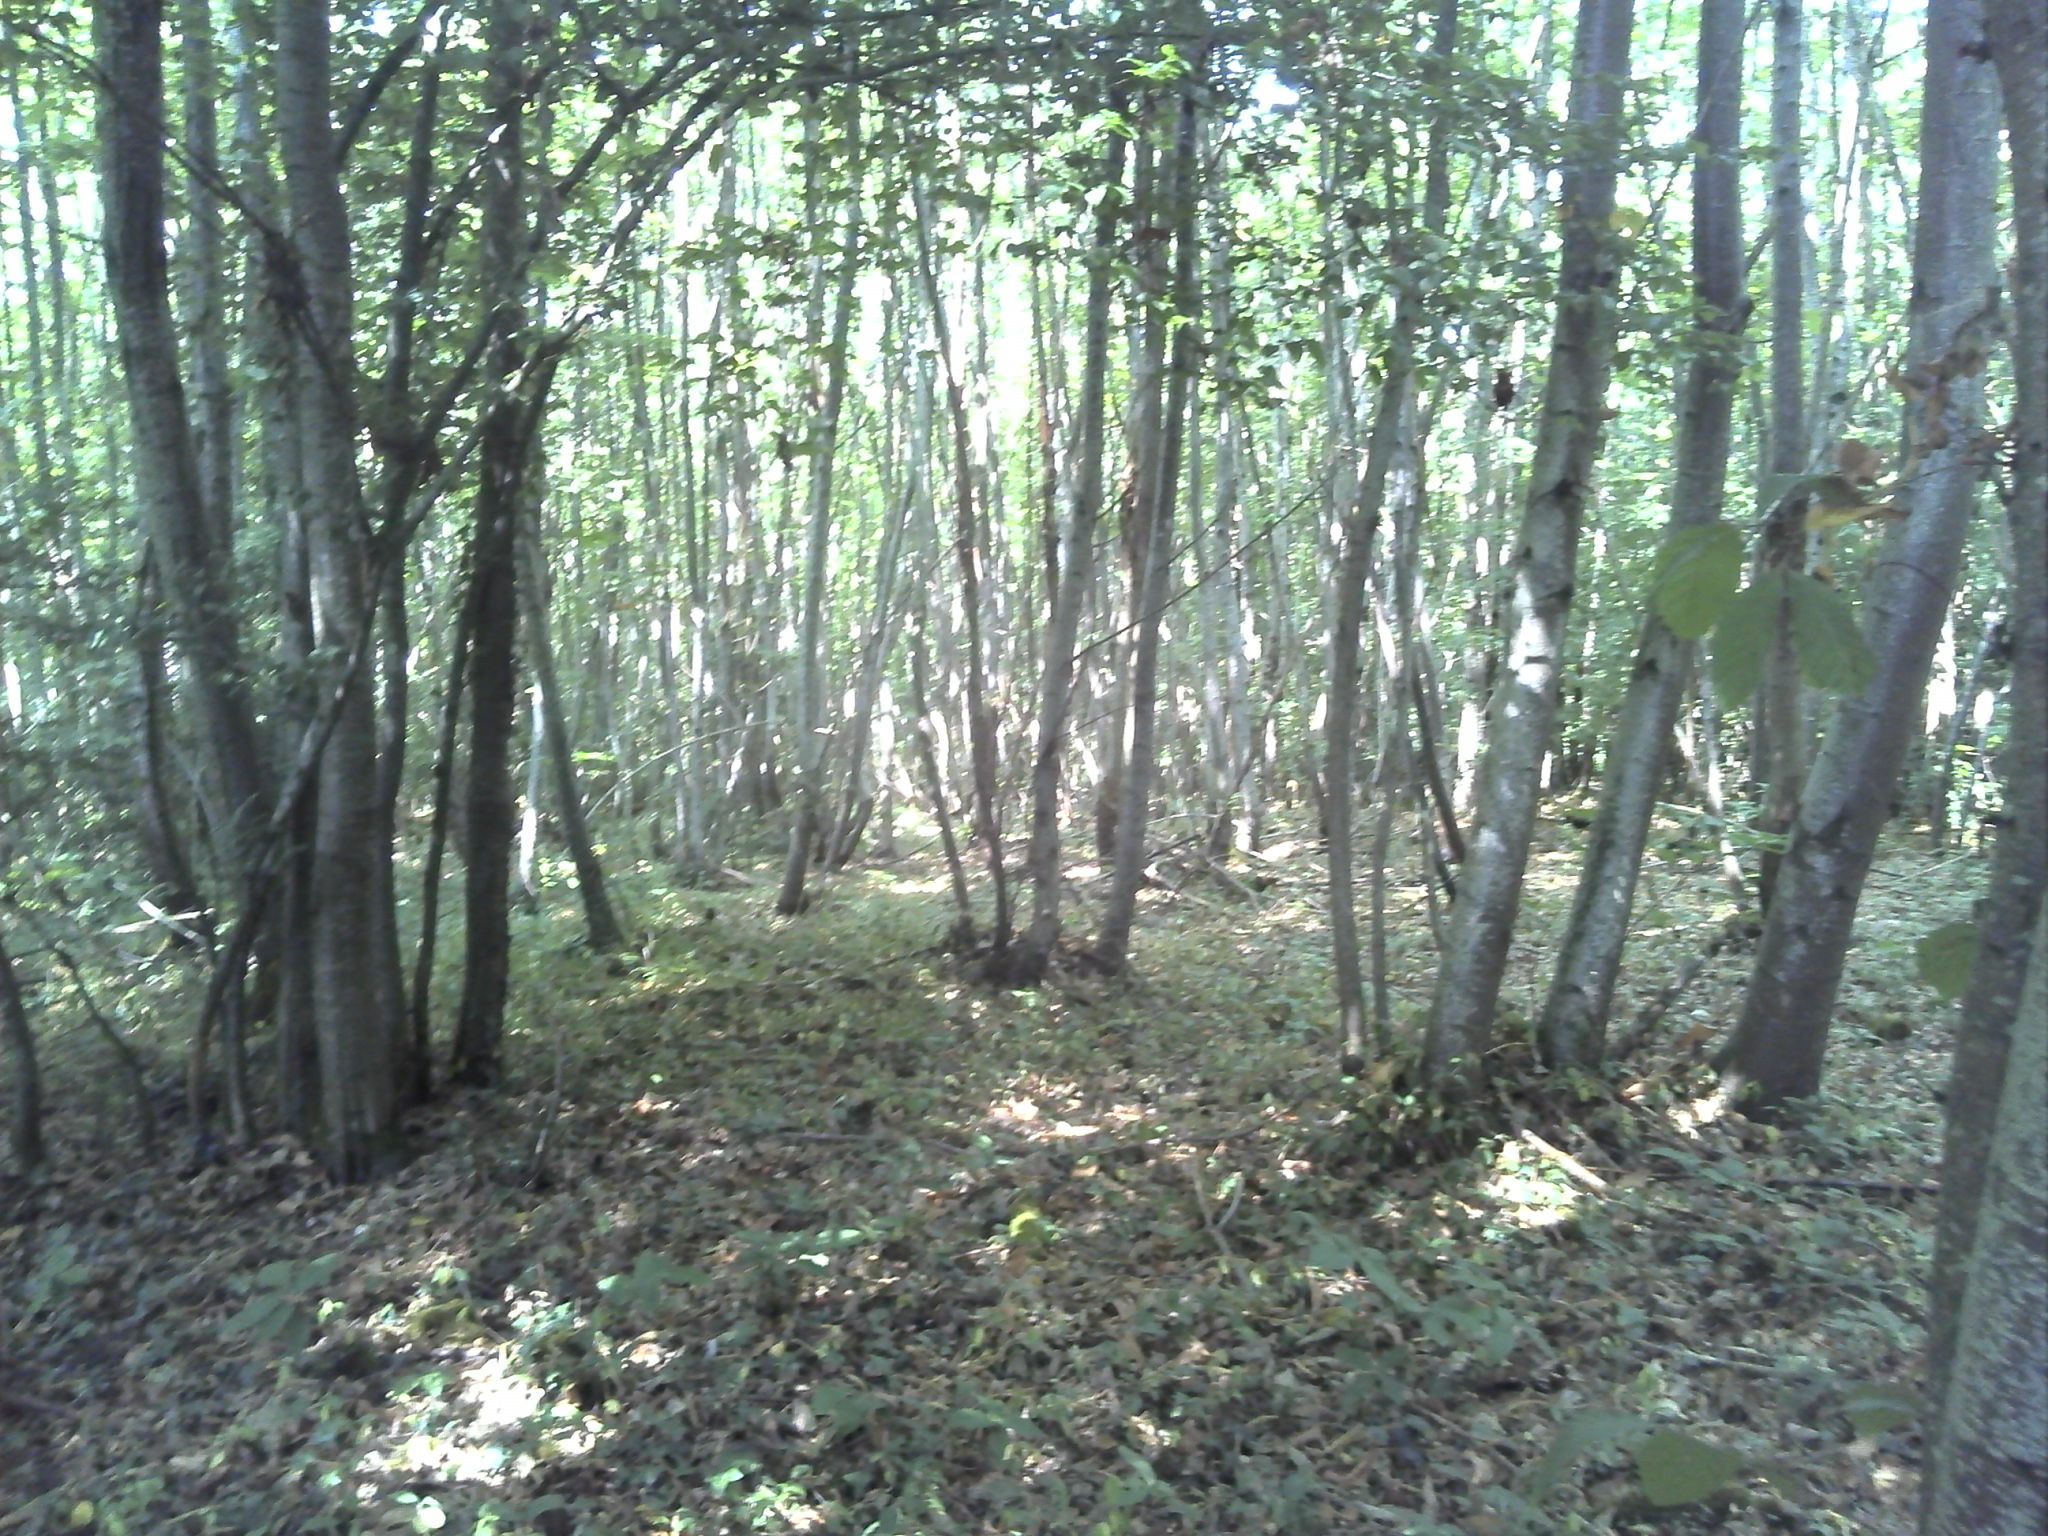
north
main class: Woodland
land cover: Broadleaved woodland
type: mesophytic deciduous forest
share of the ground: > 75 %
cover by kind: broadleaved forest trees 95 %, herbaceous plants 5 %
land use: Forestry
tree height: > 5 m
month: July
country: FR
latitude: 47.0125
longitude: 1.1061
